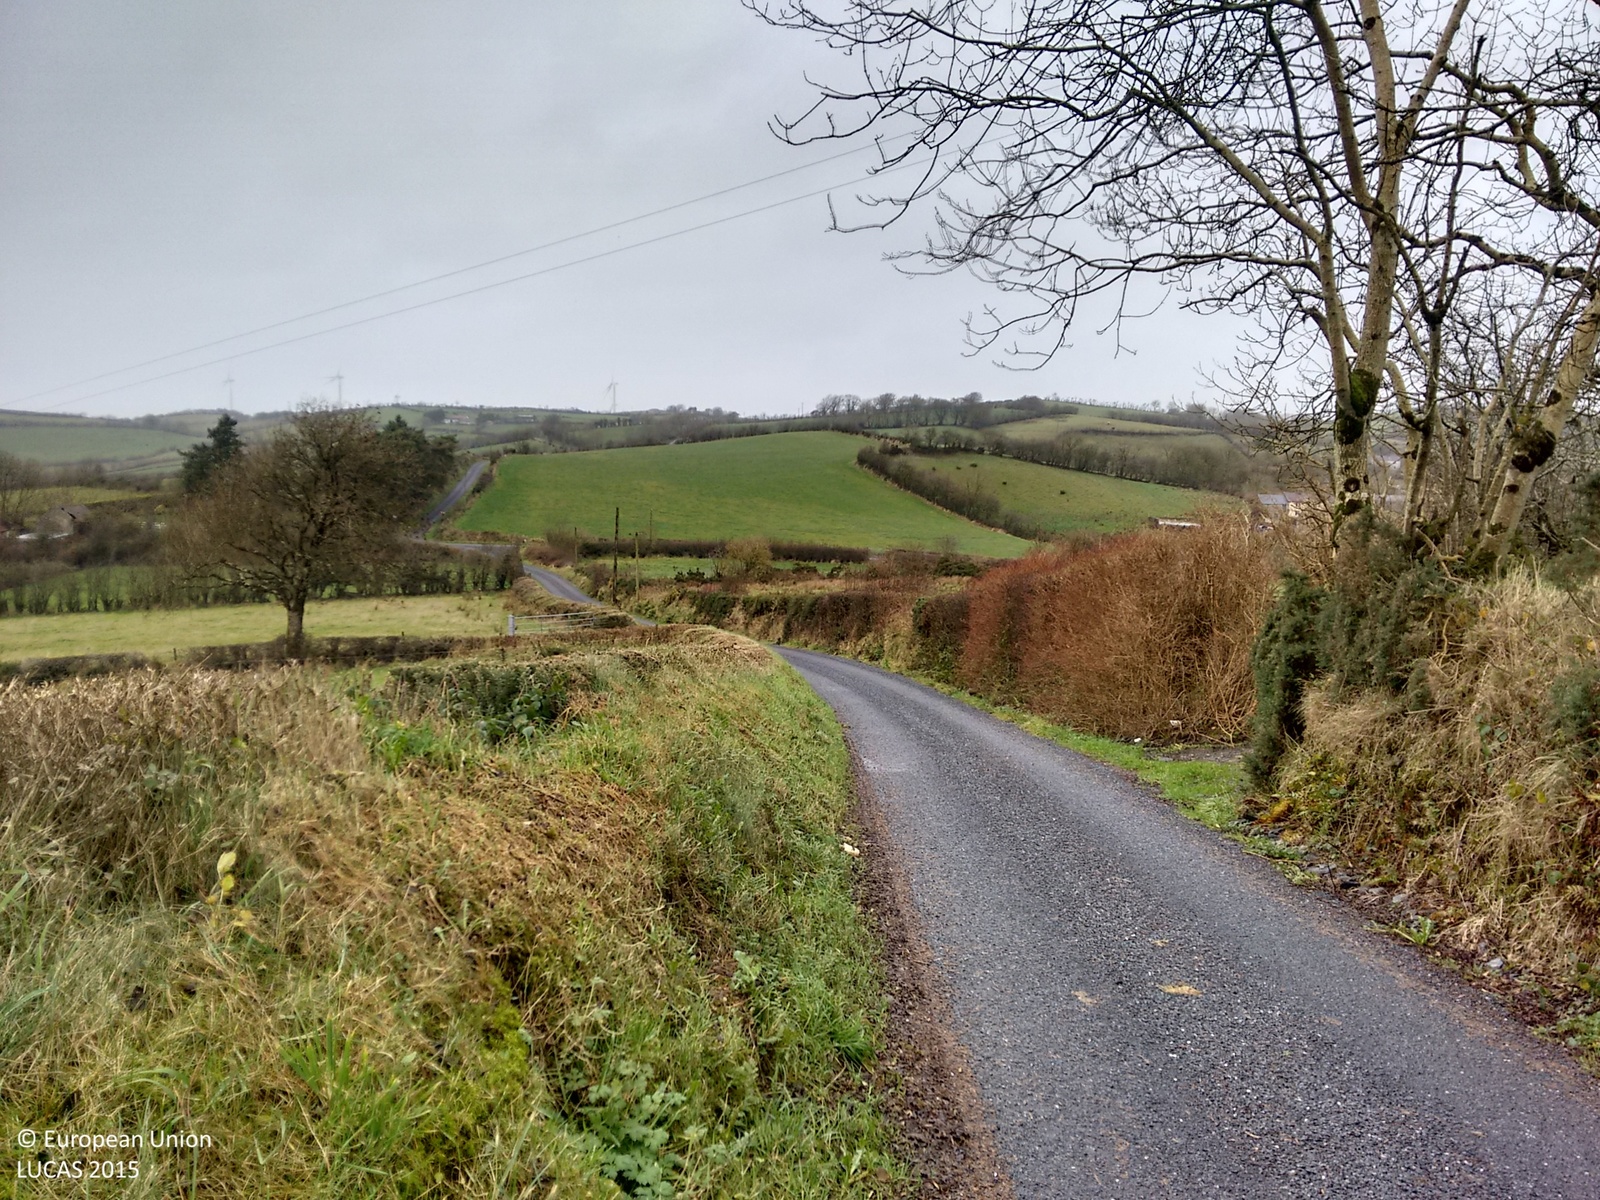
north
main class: Grassland
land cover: Grassland without tree/shrub cover
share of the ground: > 75 %
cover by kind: herbaceous plants 100 %
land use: Agriculture (excluding fallow land and kitchen gardens)
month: December
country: IE
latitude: 54.0602
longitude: -6.8972
